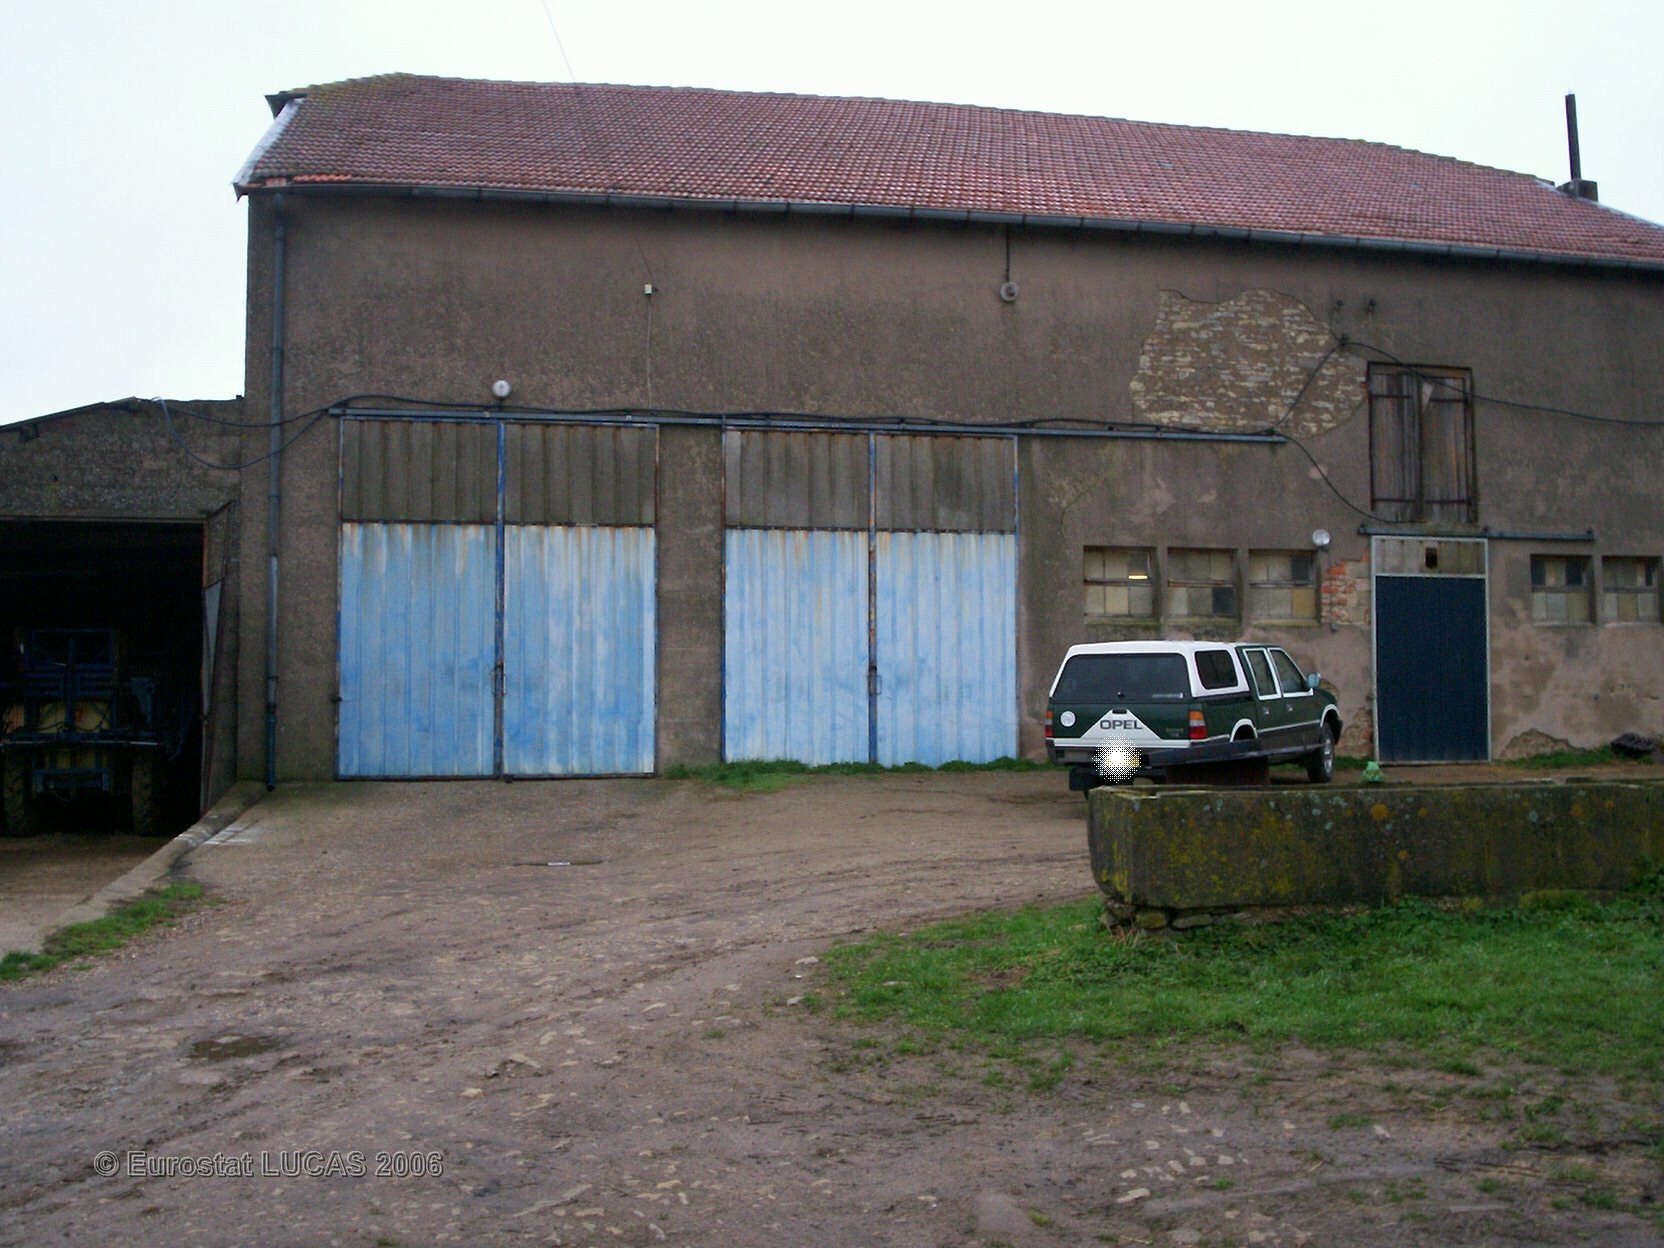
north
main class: Grassland
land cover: Grassland without tree/shrub cover
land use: Agriculture (excluding fallow land and kitchen gardens)
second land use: Residential
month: April
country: FR
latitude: 48.7228
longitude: 6.9964
